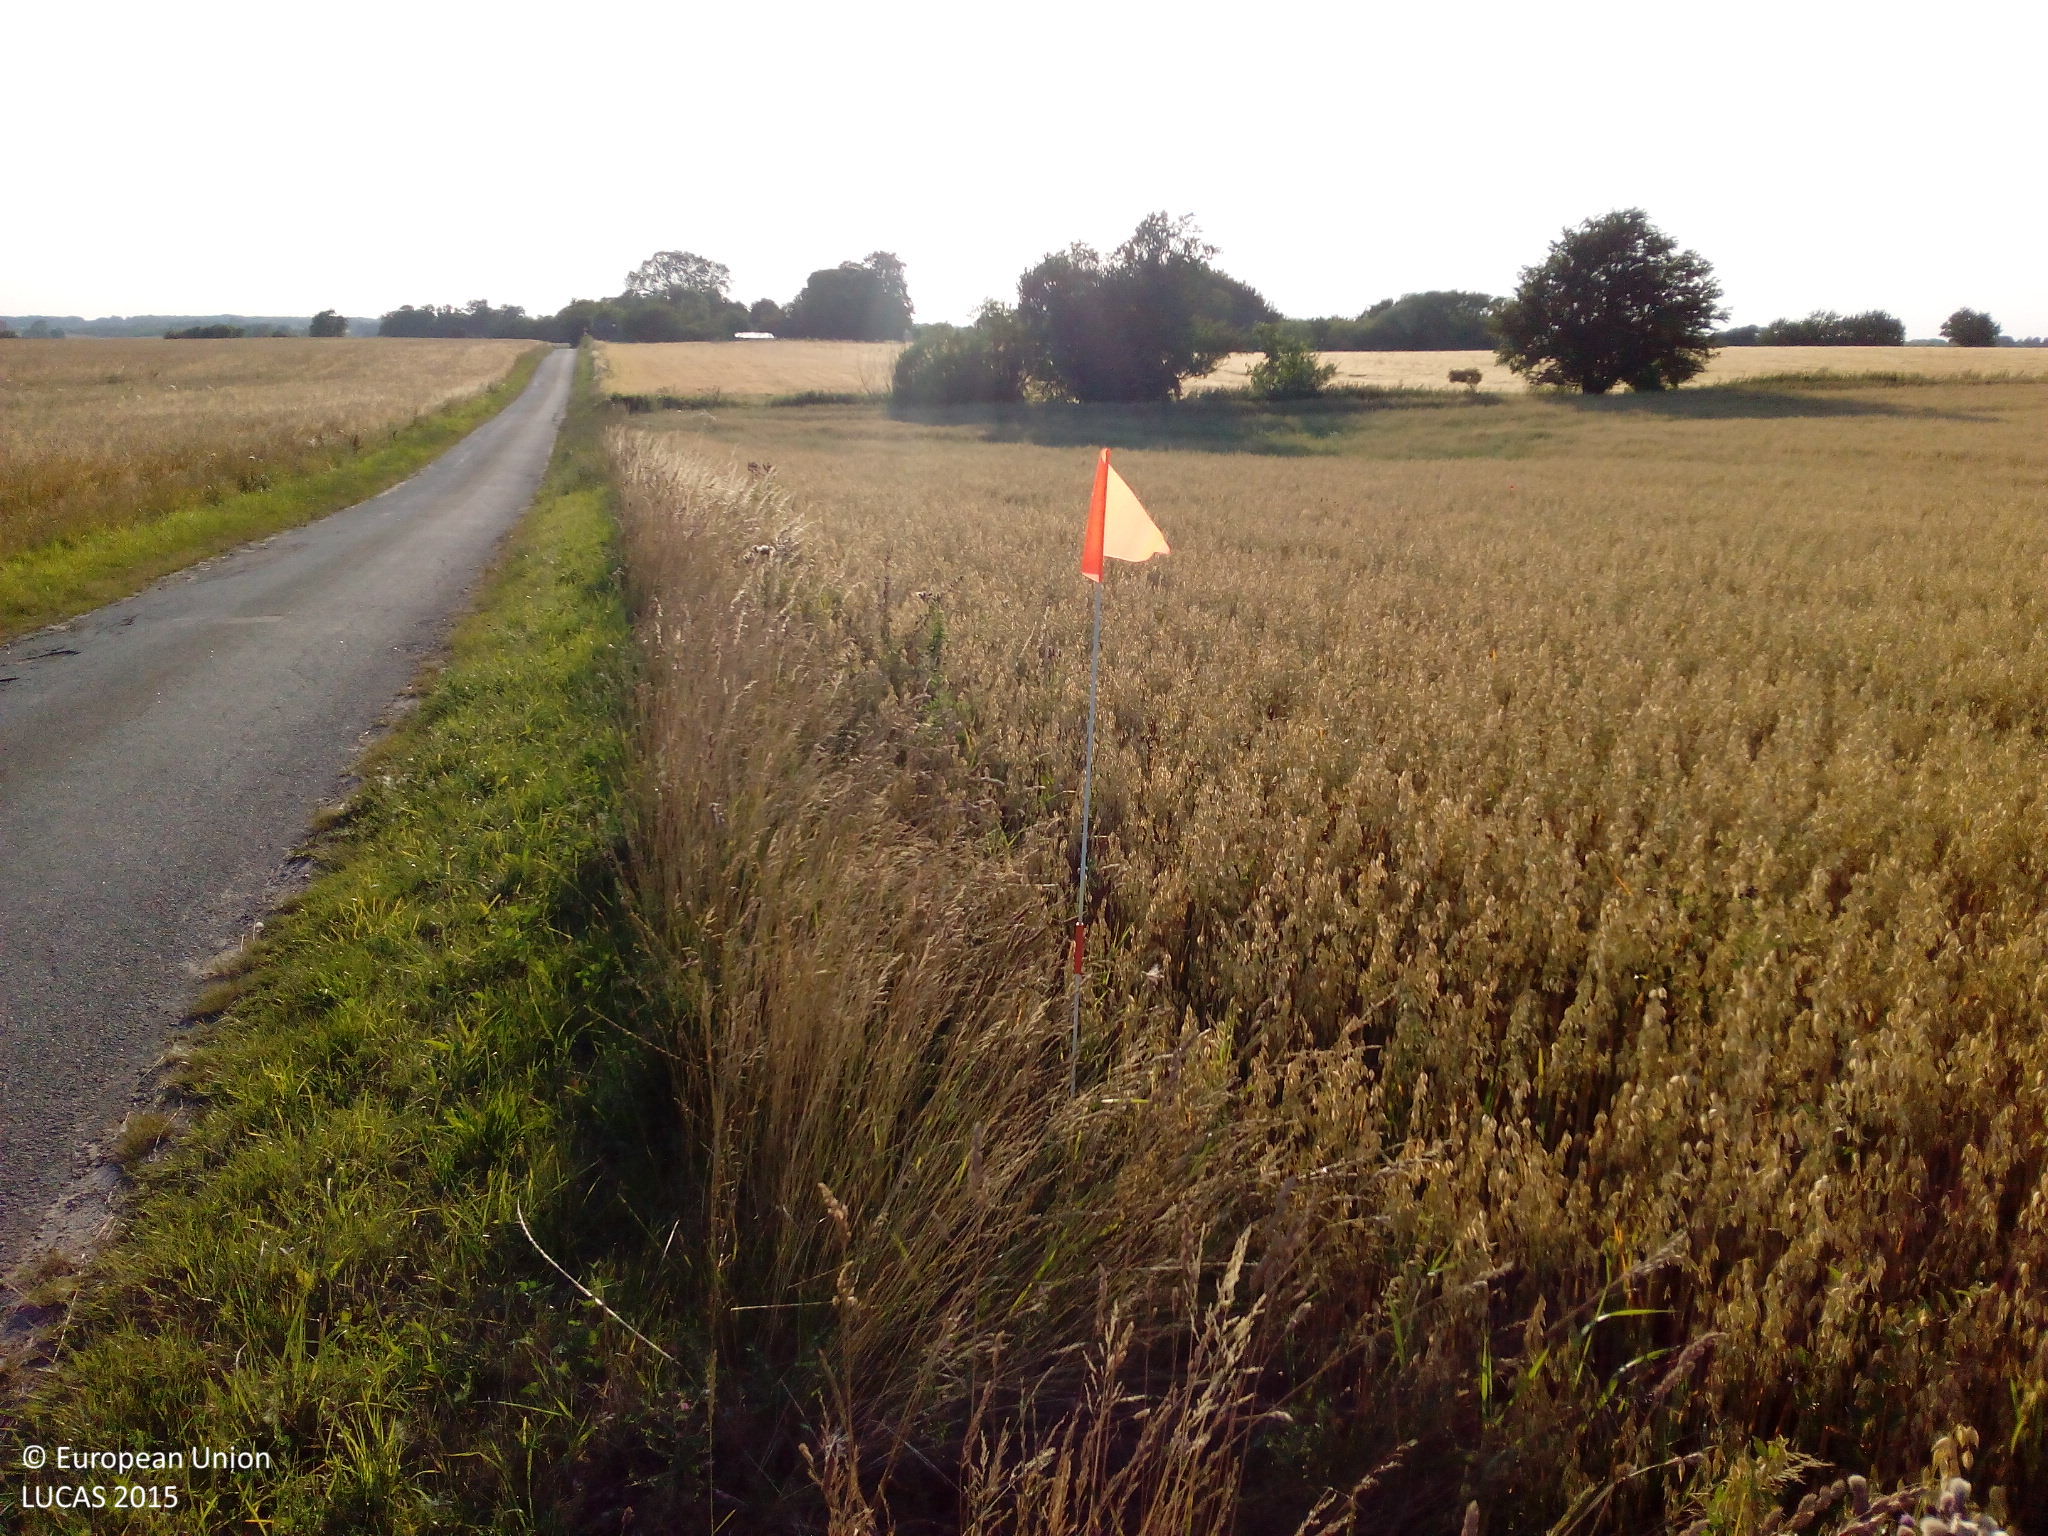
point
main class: Cropland
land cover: Oats
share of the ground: > 75 %
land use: Agriculture (excluding fallow land and kitchen gardens)
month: August
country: DK
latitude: 55.6699
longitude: 11.9221
